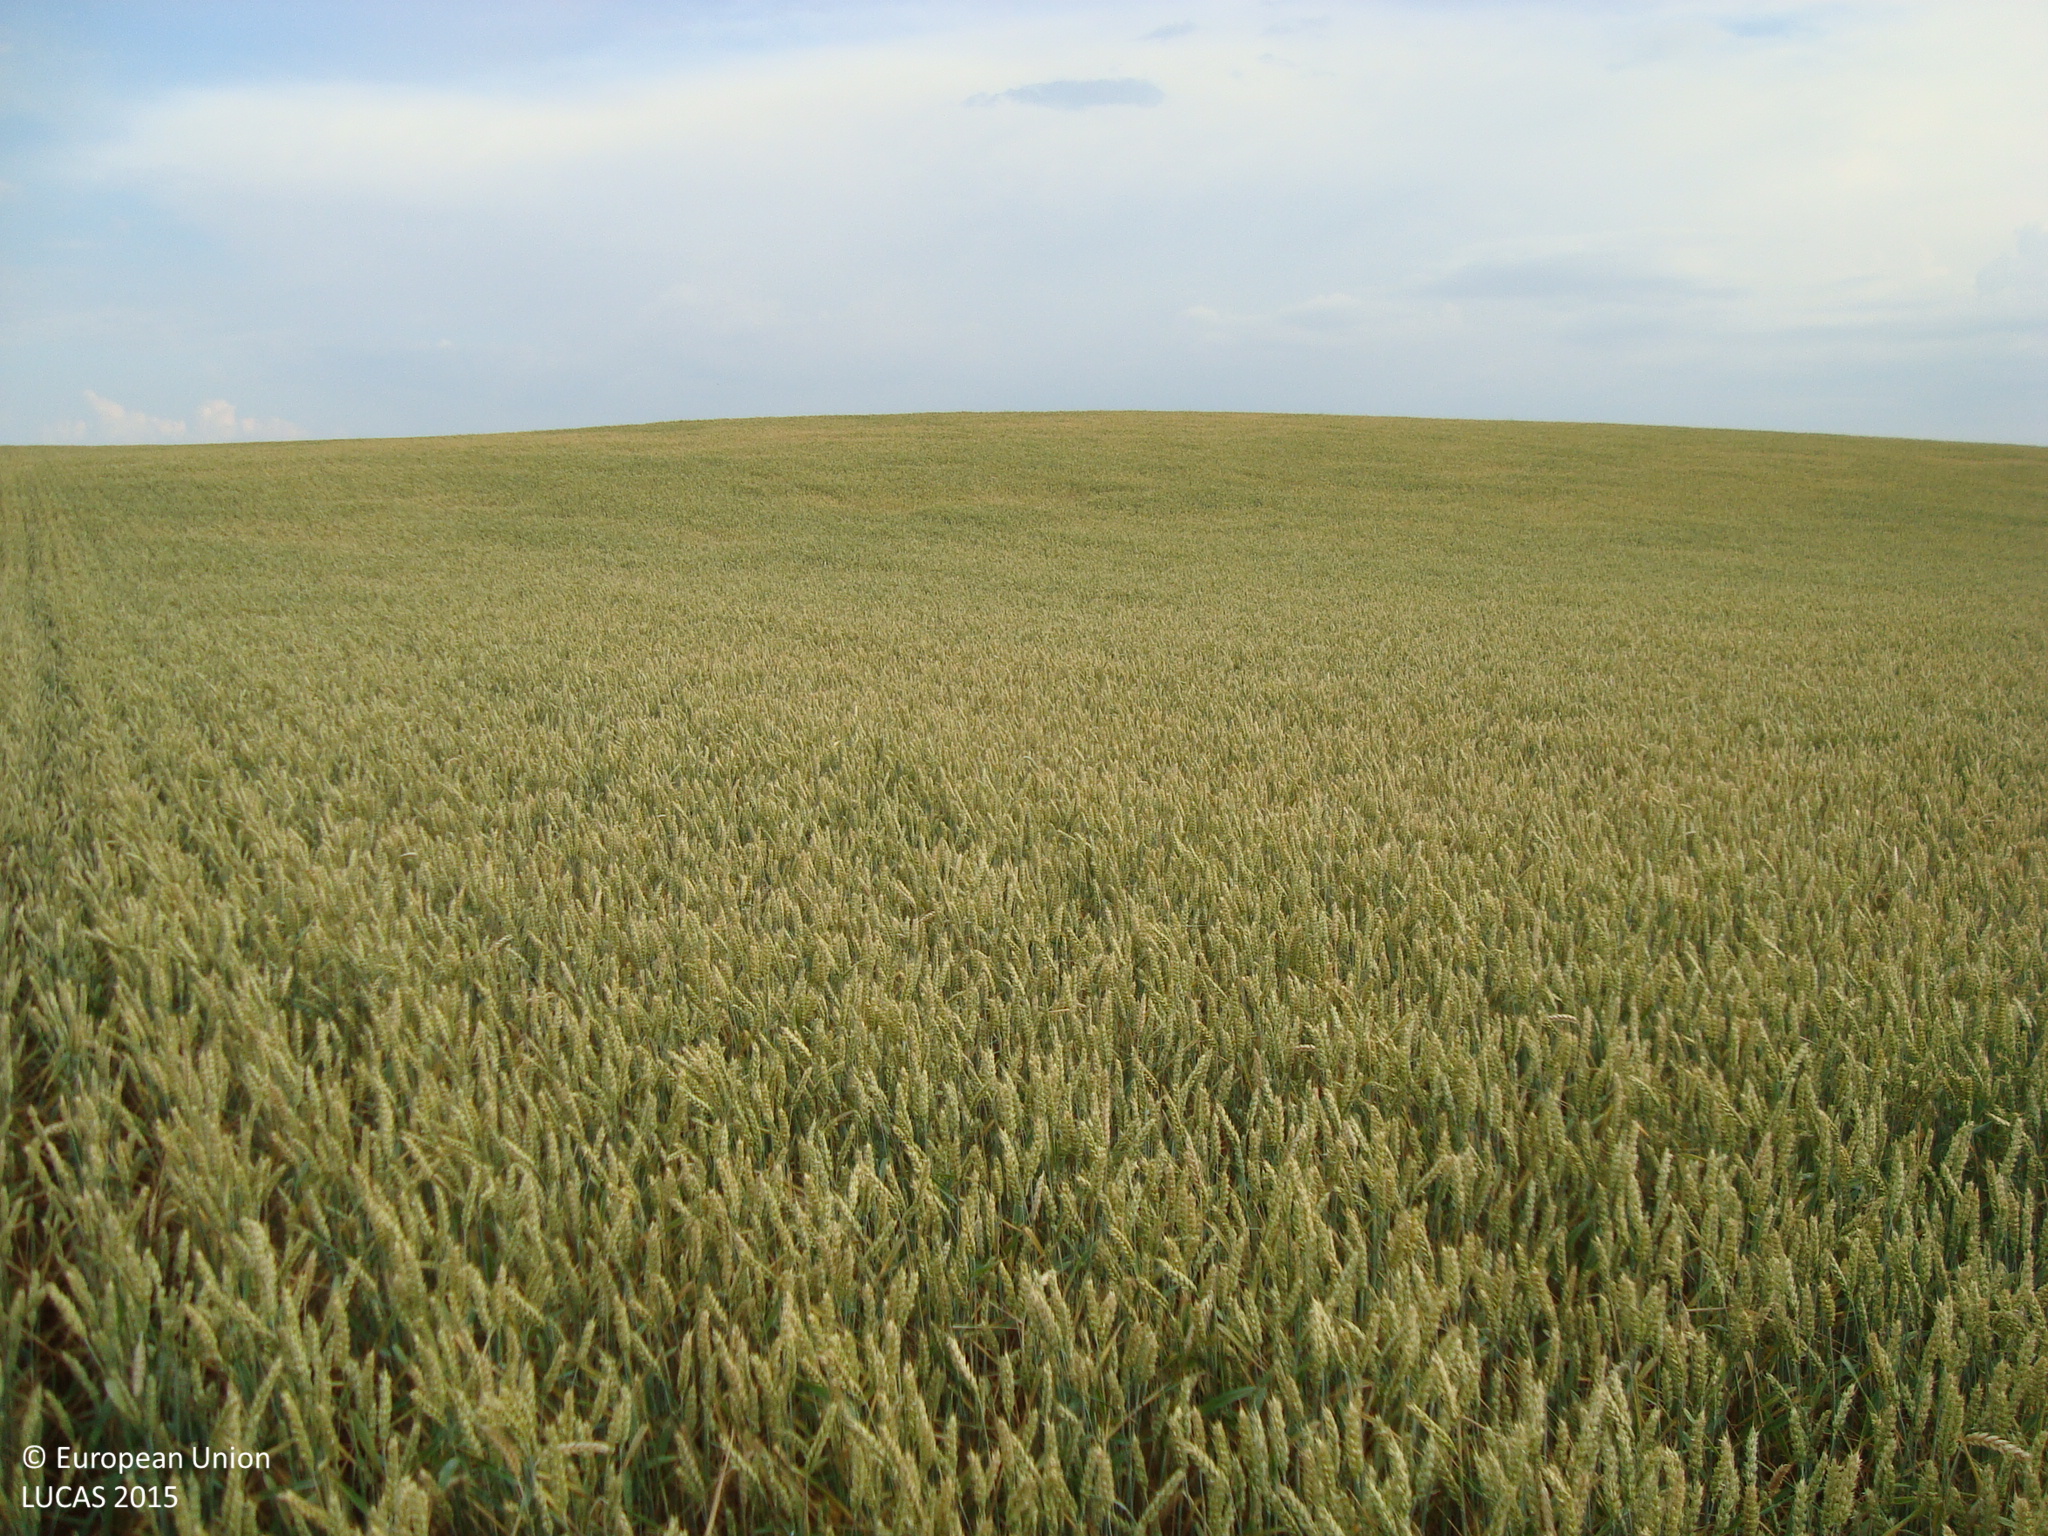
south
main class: Cropland
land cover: Common wheat
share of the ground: > 75 %
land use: Agriculture (excluding fallow land and kitchen gardens)
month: June
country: ES
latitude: 41.8540
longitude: -3.7758
